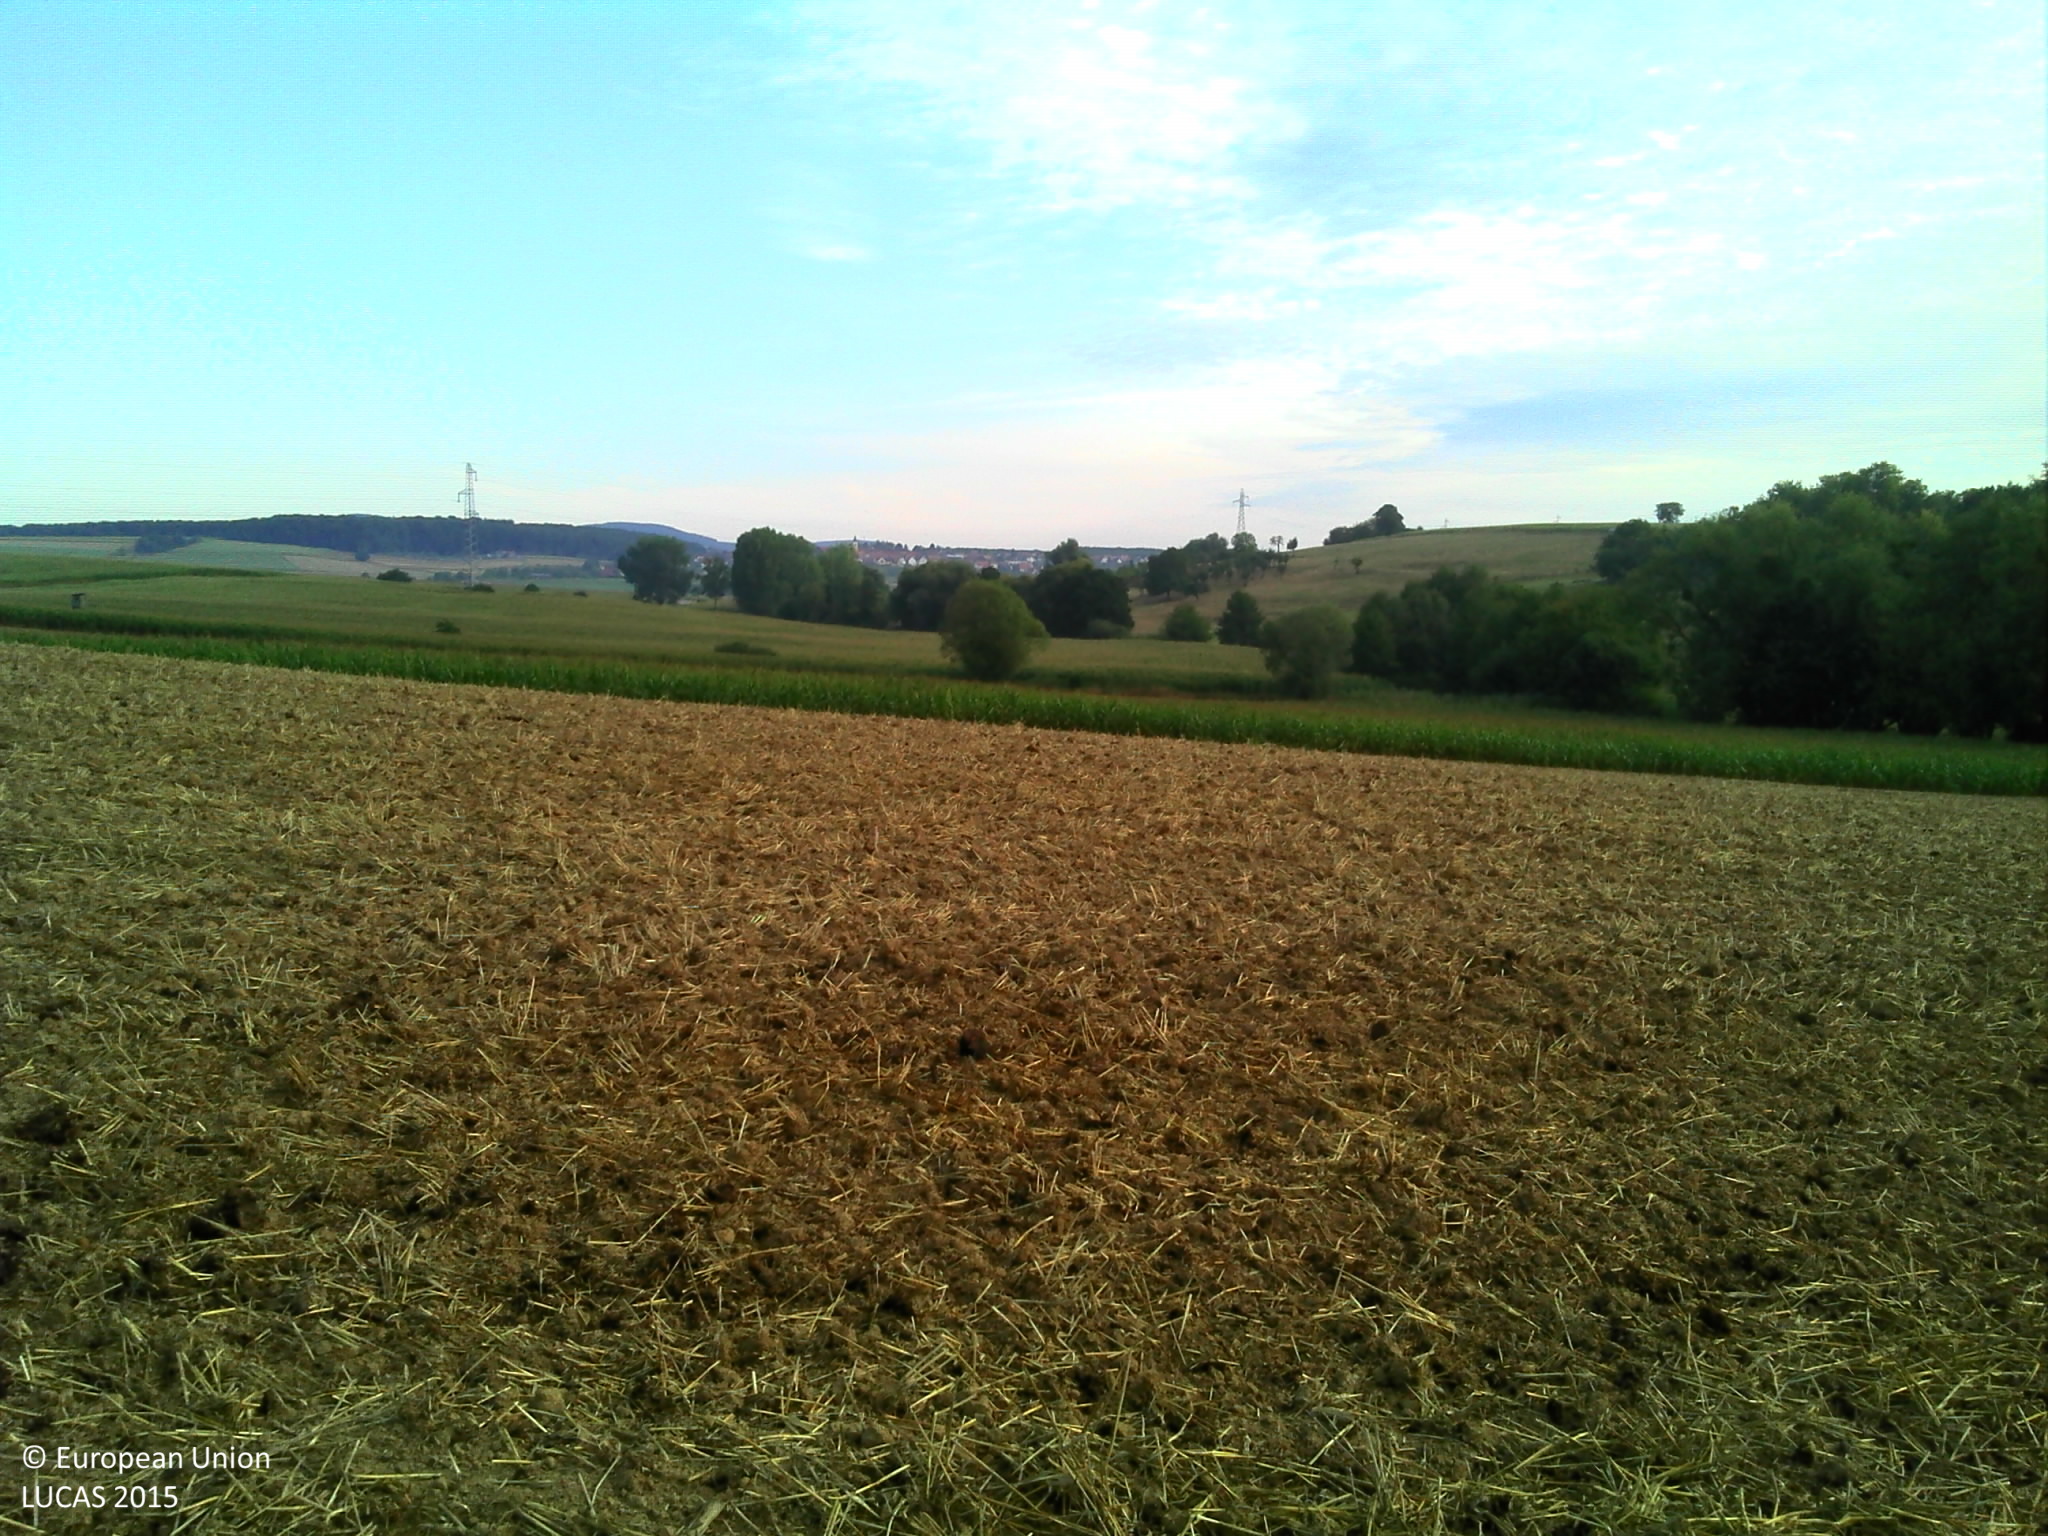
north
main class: Cropland
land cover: Common wheat
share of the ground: < 10 %
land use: Agriculture (excluding fallow land and kitchen gardens)
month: August
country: FR
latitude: 48.8638
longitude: 7.6151
